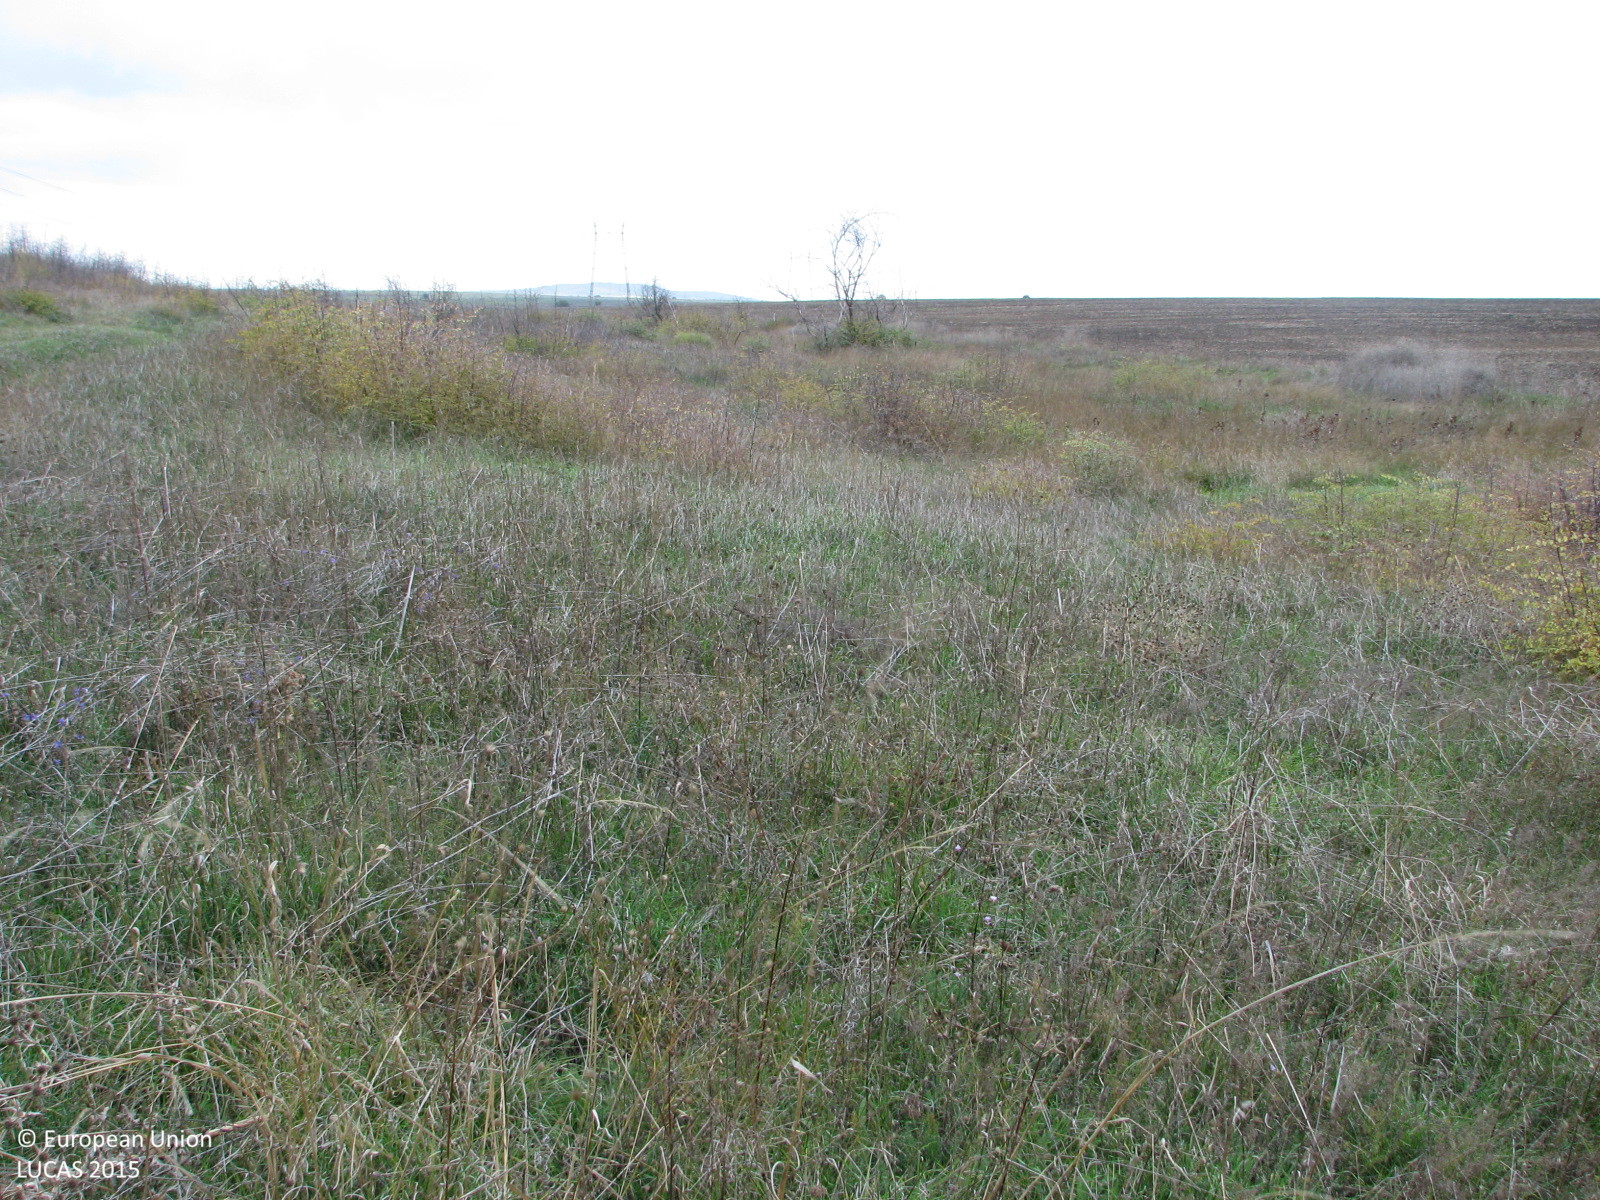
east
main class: Grassland
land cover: Grassland with sparse tree/shrub cover
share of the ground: > 75 %
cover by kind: herbaceous plants 90 %, broadleaved forest trees 5 %, shrubs 5 %
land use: Semi-natural and natural areas not in use
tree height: < 5 m
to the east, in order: Tracks; Grassland with sparse tree/shrub cover; Grassland without tree/shrub cover; Common wheat
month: October
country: BG
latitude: 42.2304
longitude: 26.7056
